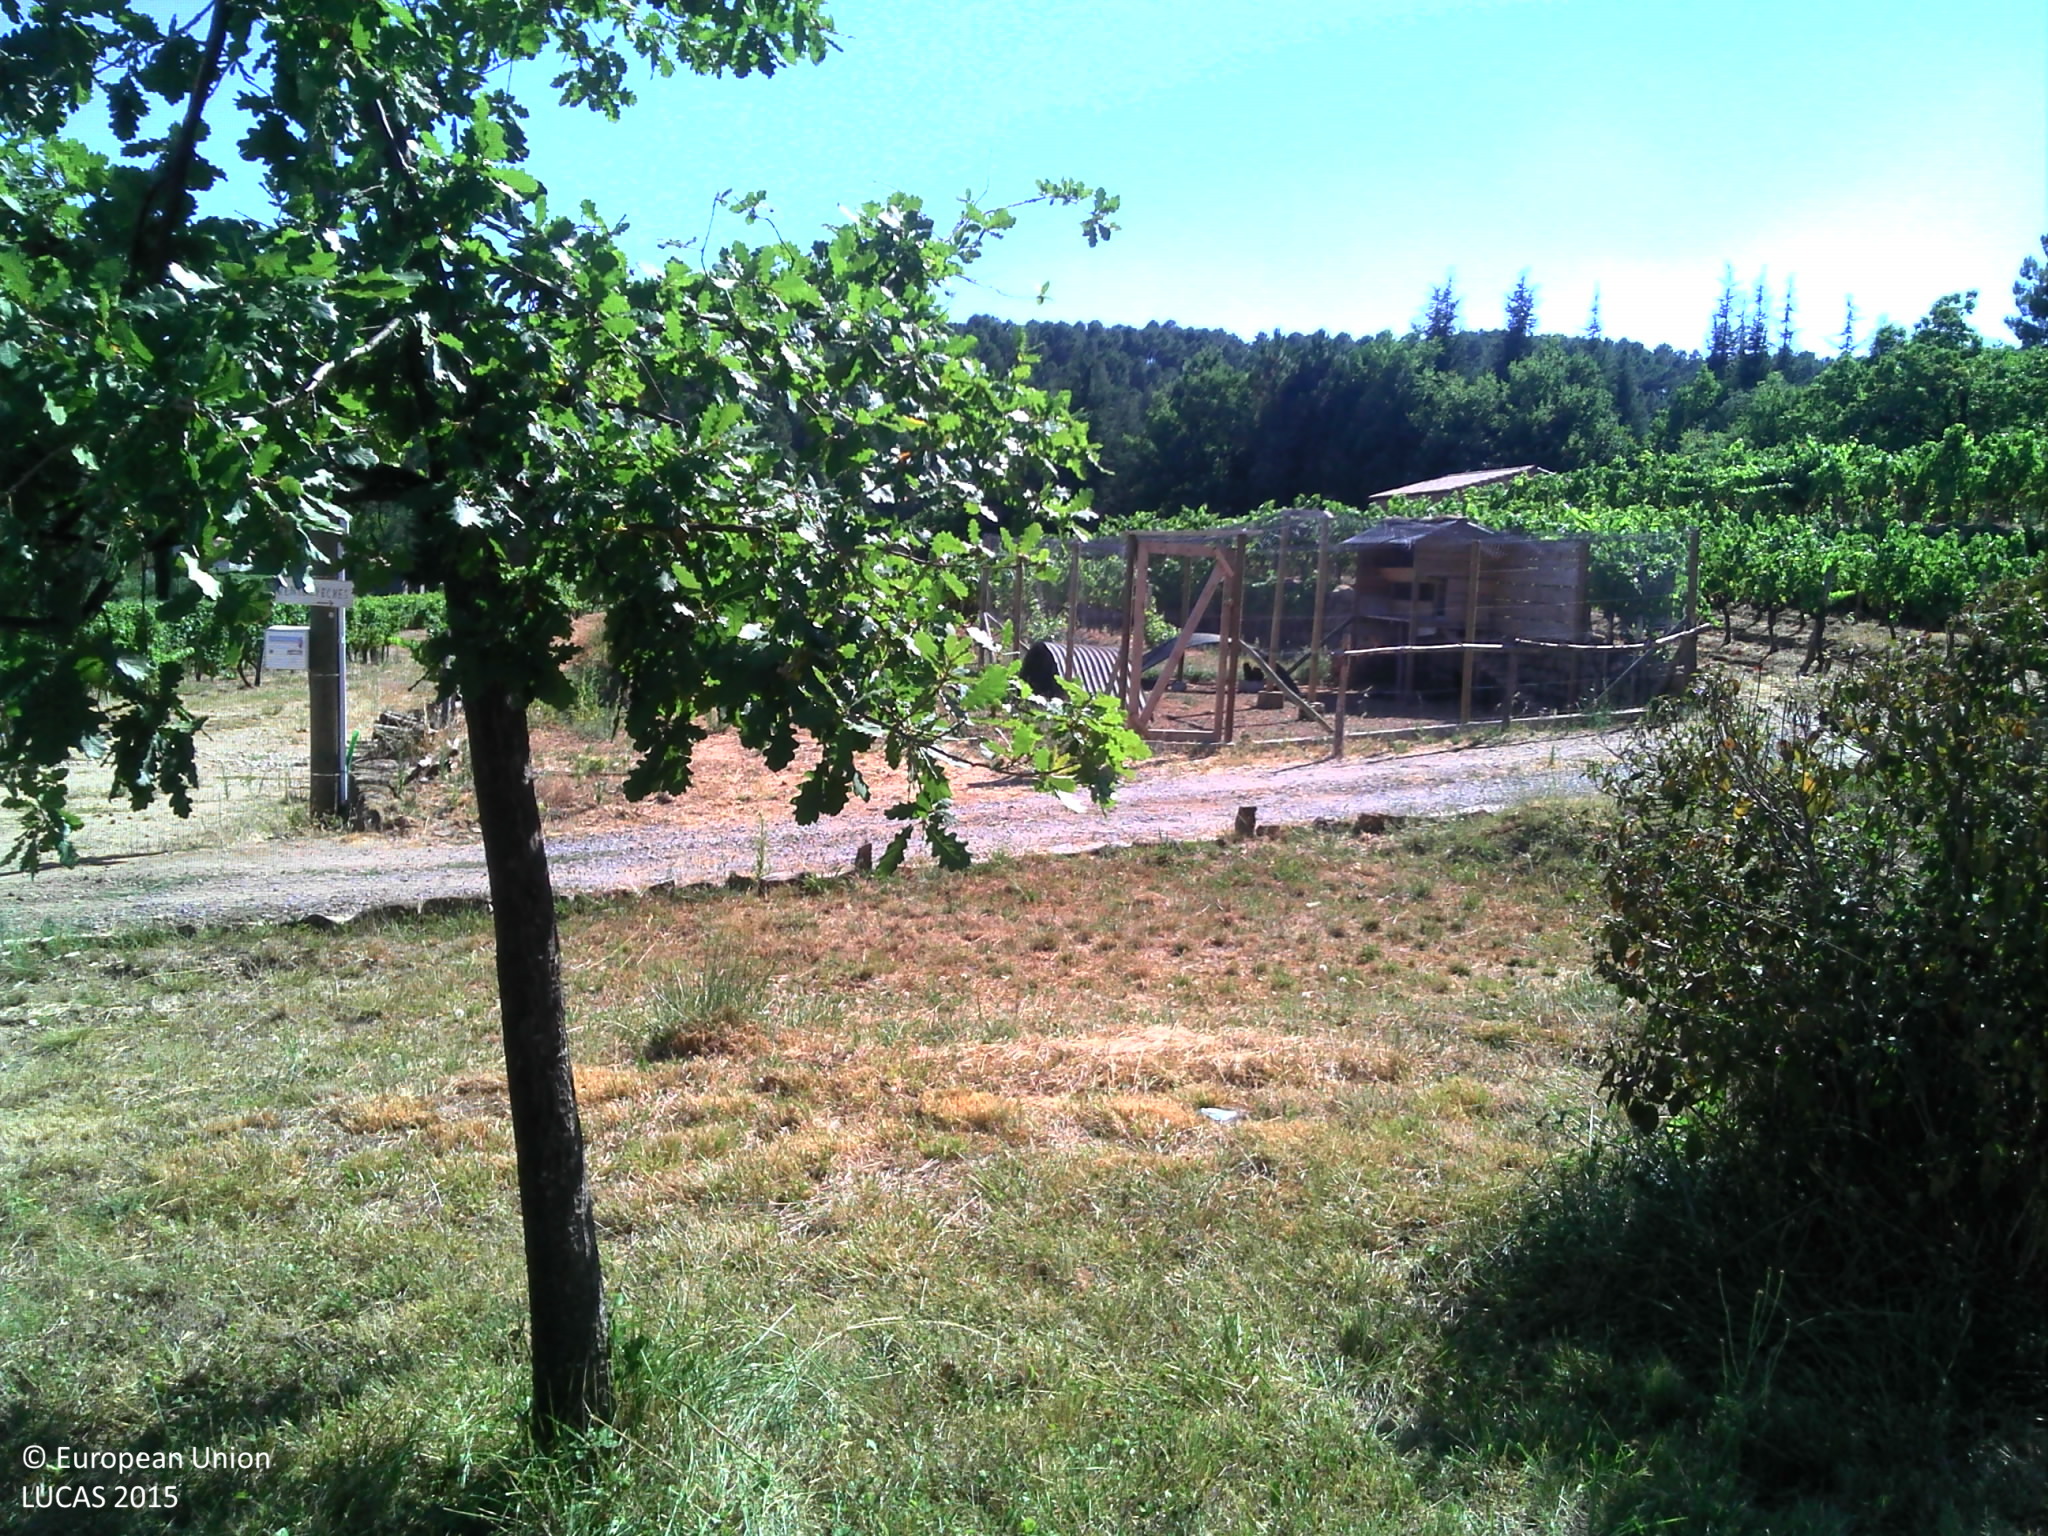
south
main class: Grassland
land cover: Grassland with sparse tree/shrub cover
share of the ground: > 75 %
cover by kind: herbaceous plants 95 %, broadleaved forest trees 5 %
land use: Residential
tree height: < 5 m
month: July
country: FR
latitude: 44.5349
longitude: 4.2552
